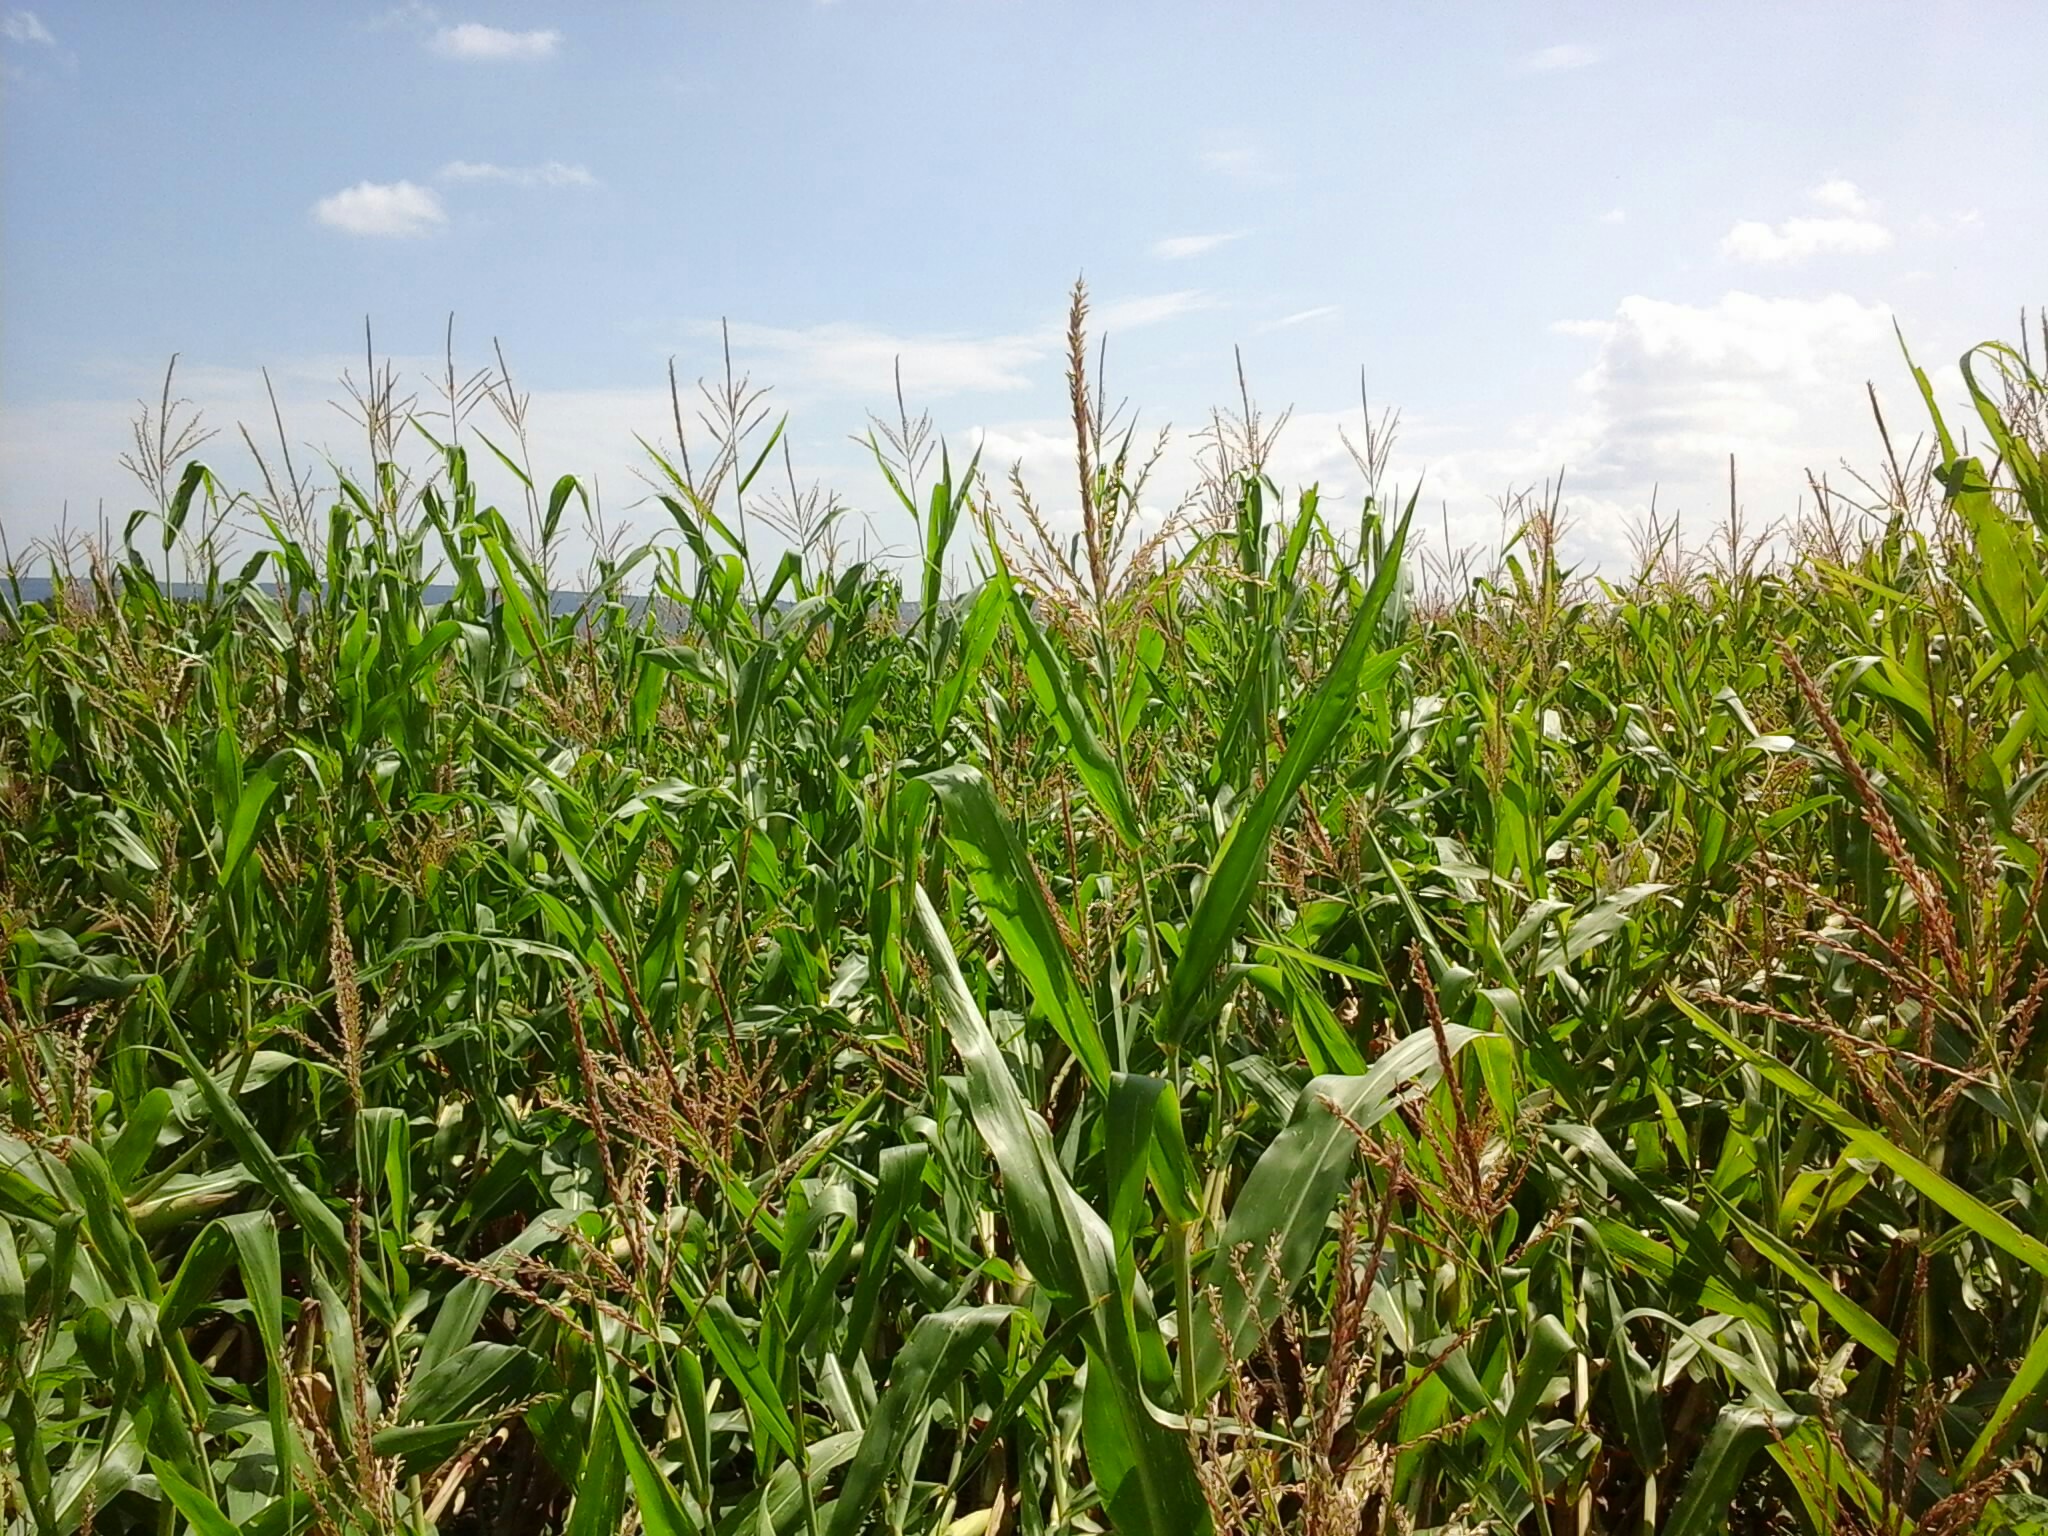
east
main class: Cropland
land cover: Maize
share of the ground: > 75 %
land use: Agriculture (excluding fallow land and kitchen gardens)
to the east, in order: Maize
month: August
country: HU
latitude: 47.6007
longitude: 18.3259
